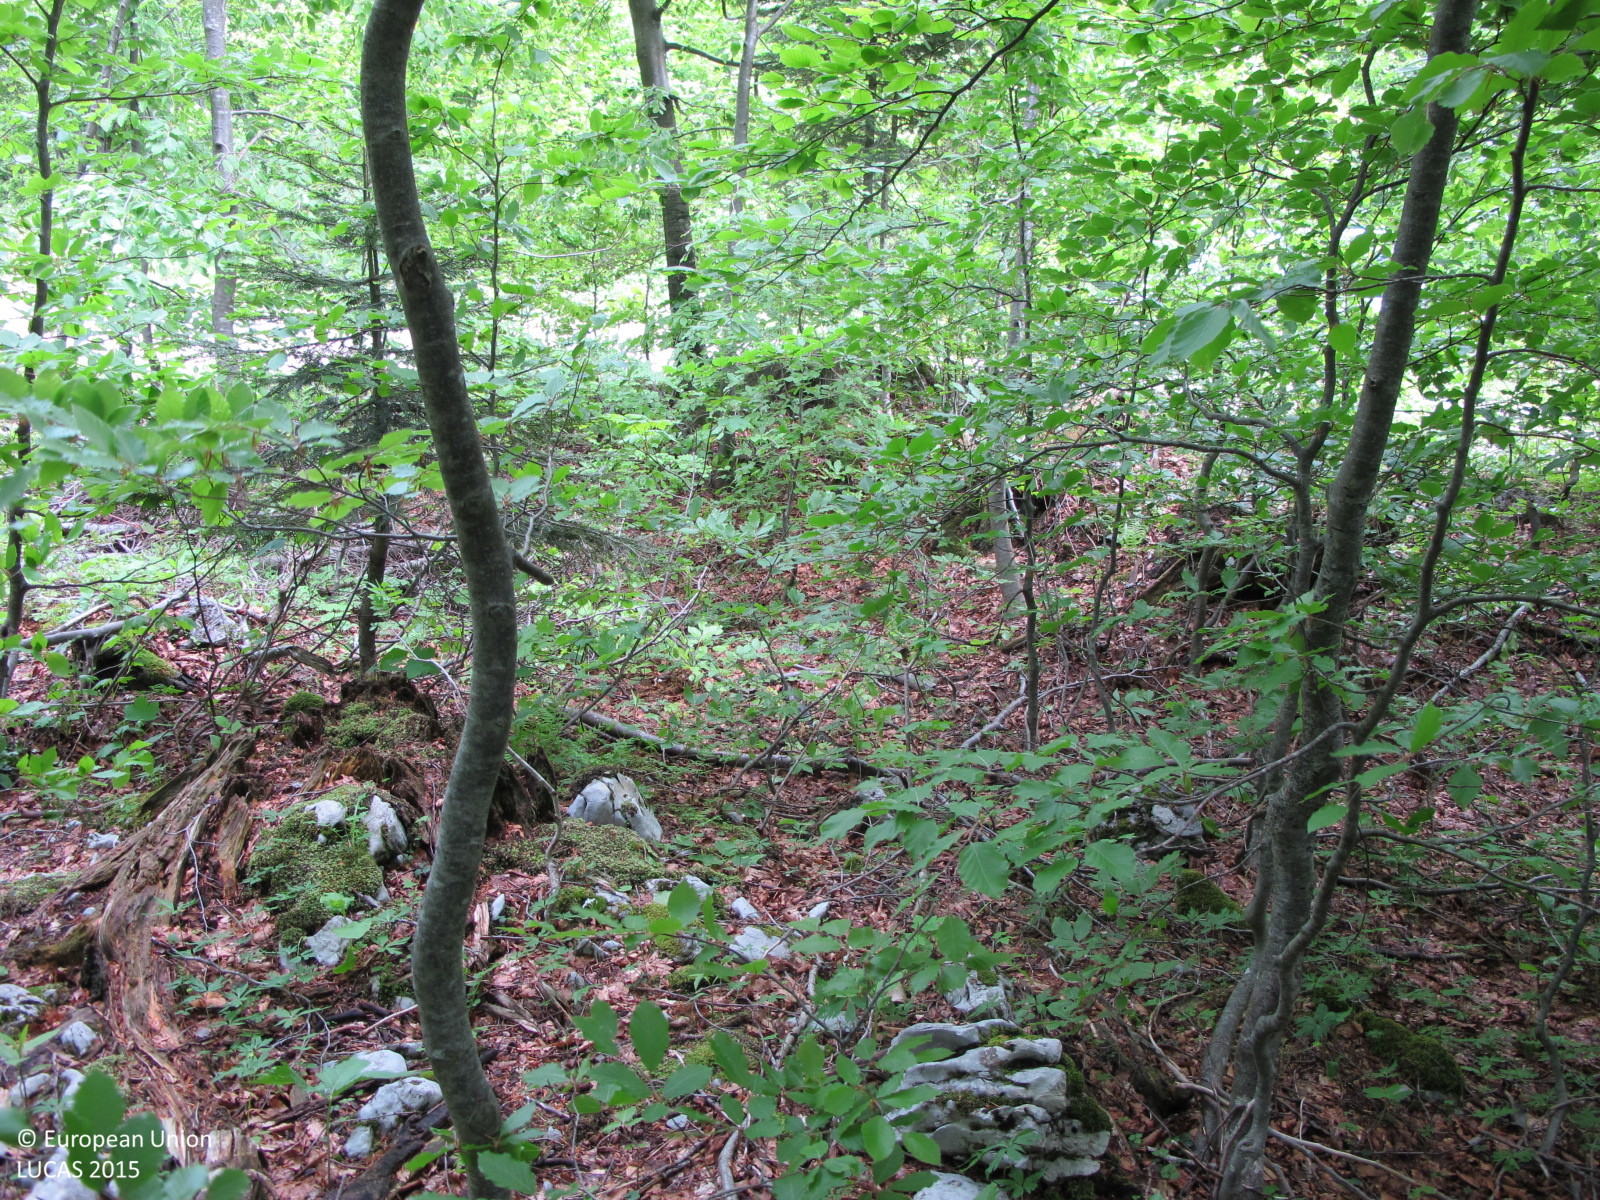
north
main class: Woodland
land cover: Broadleaved woodland
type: mountainous beech forest
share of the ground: > 75 %
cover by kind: broadleaved forest trees 80 %, coniferous forest trees 5 %, shrubs 5 %, herbaceous plants 5 %, consolidated bare surface 5 %
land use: Forestry
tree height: > 5 m
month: May
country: HR
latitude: 45.4421
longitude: 14.5593
